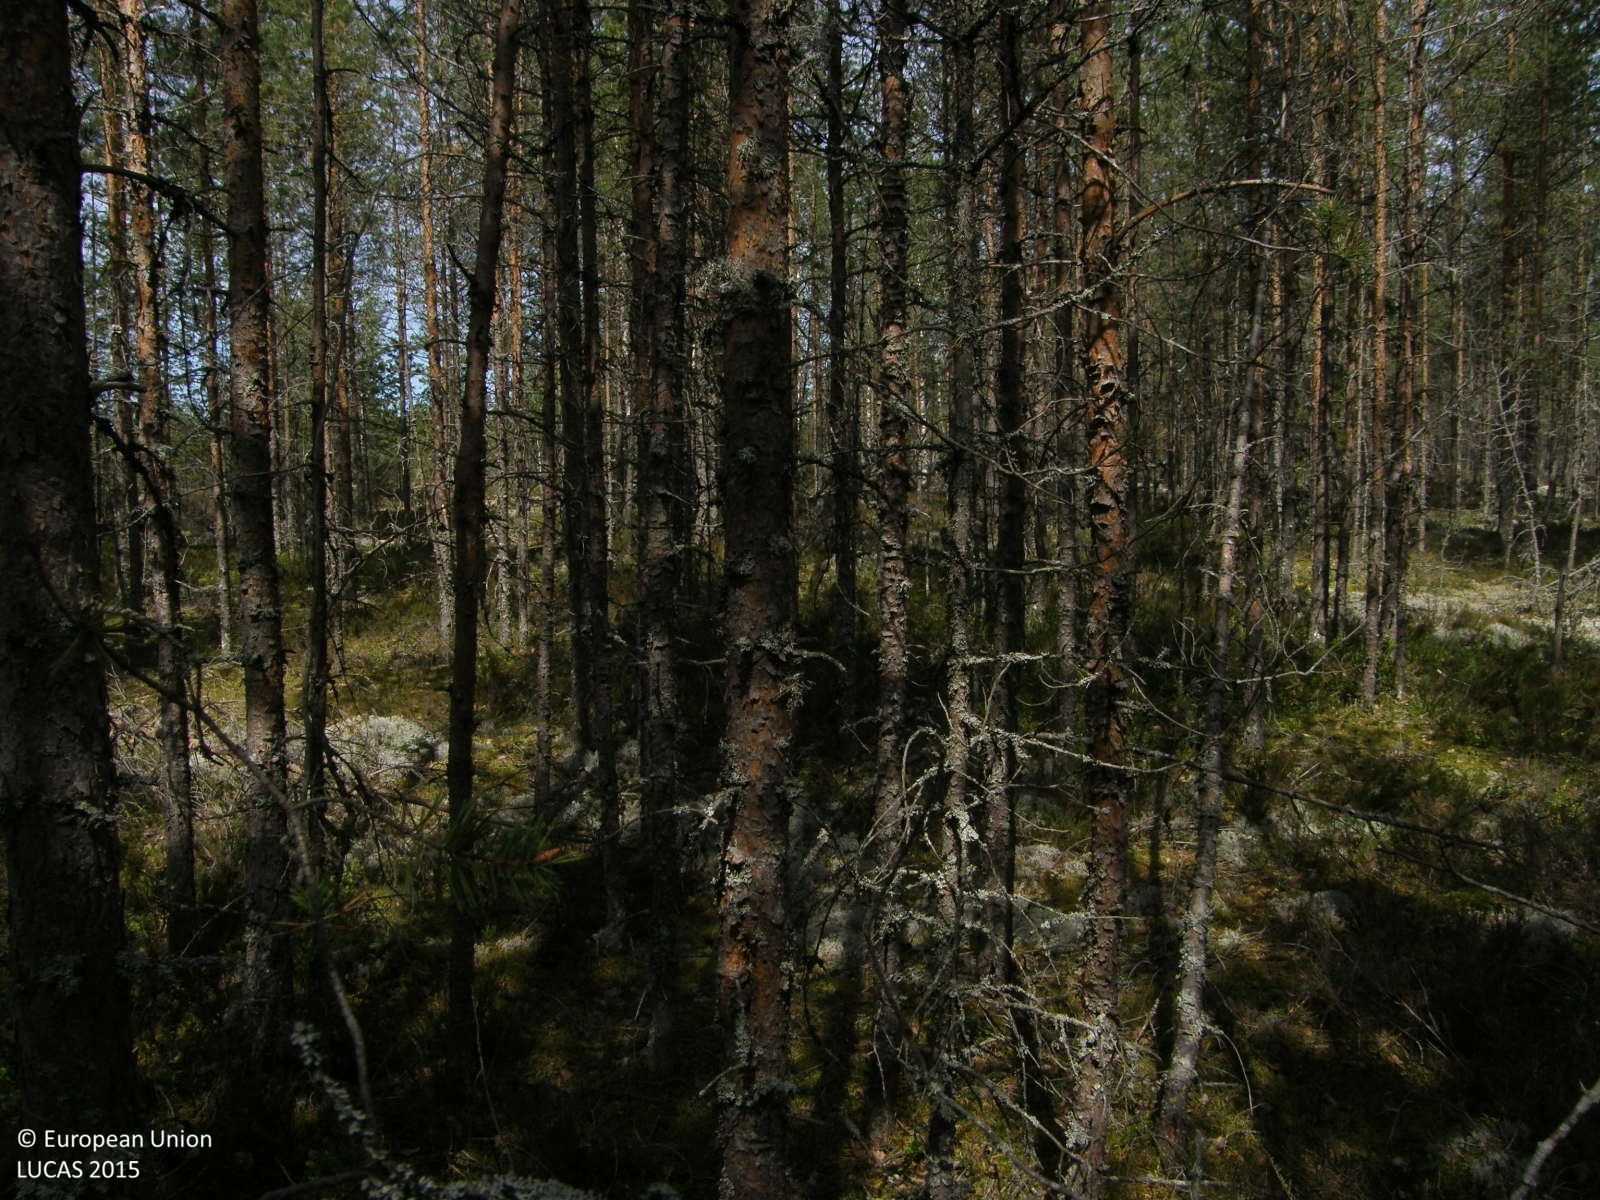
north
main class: Woodland
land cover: Pine dominated coniferous woodland
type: boreal forest
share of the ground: > 75 %
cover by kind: coniferous forest trees 90 %, broadleaved forest trees 5 %, lichens and mosses 5 %
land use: Forestry
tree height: > 5 m
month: June
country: FI
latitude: 62.1382
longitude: 22.3514
